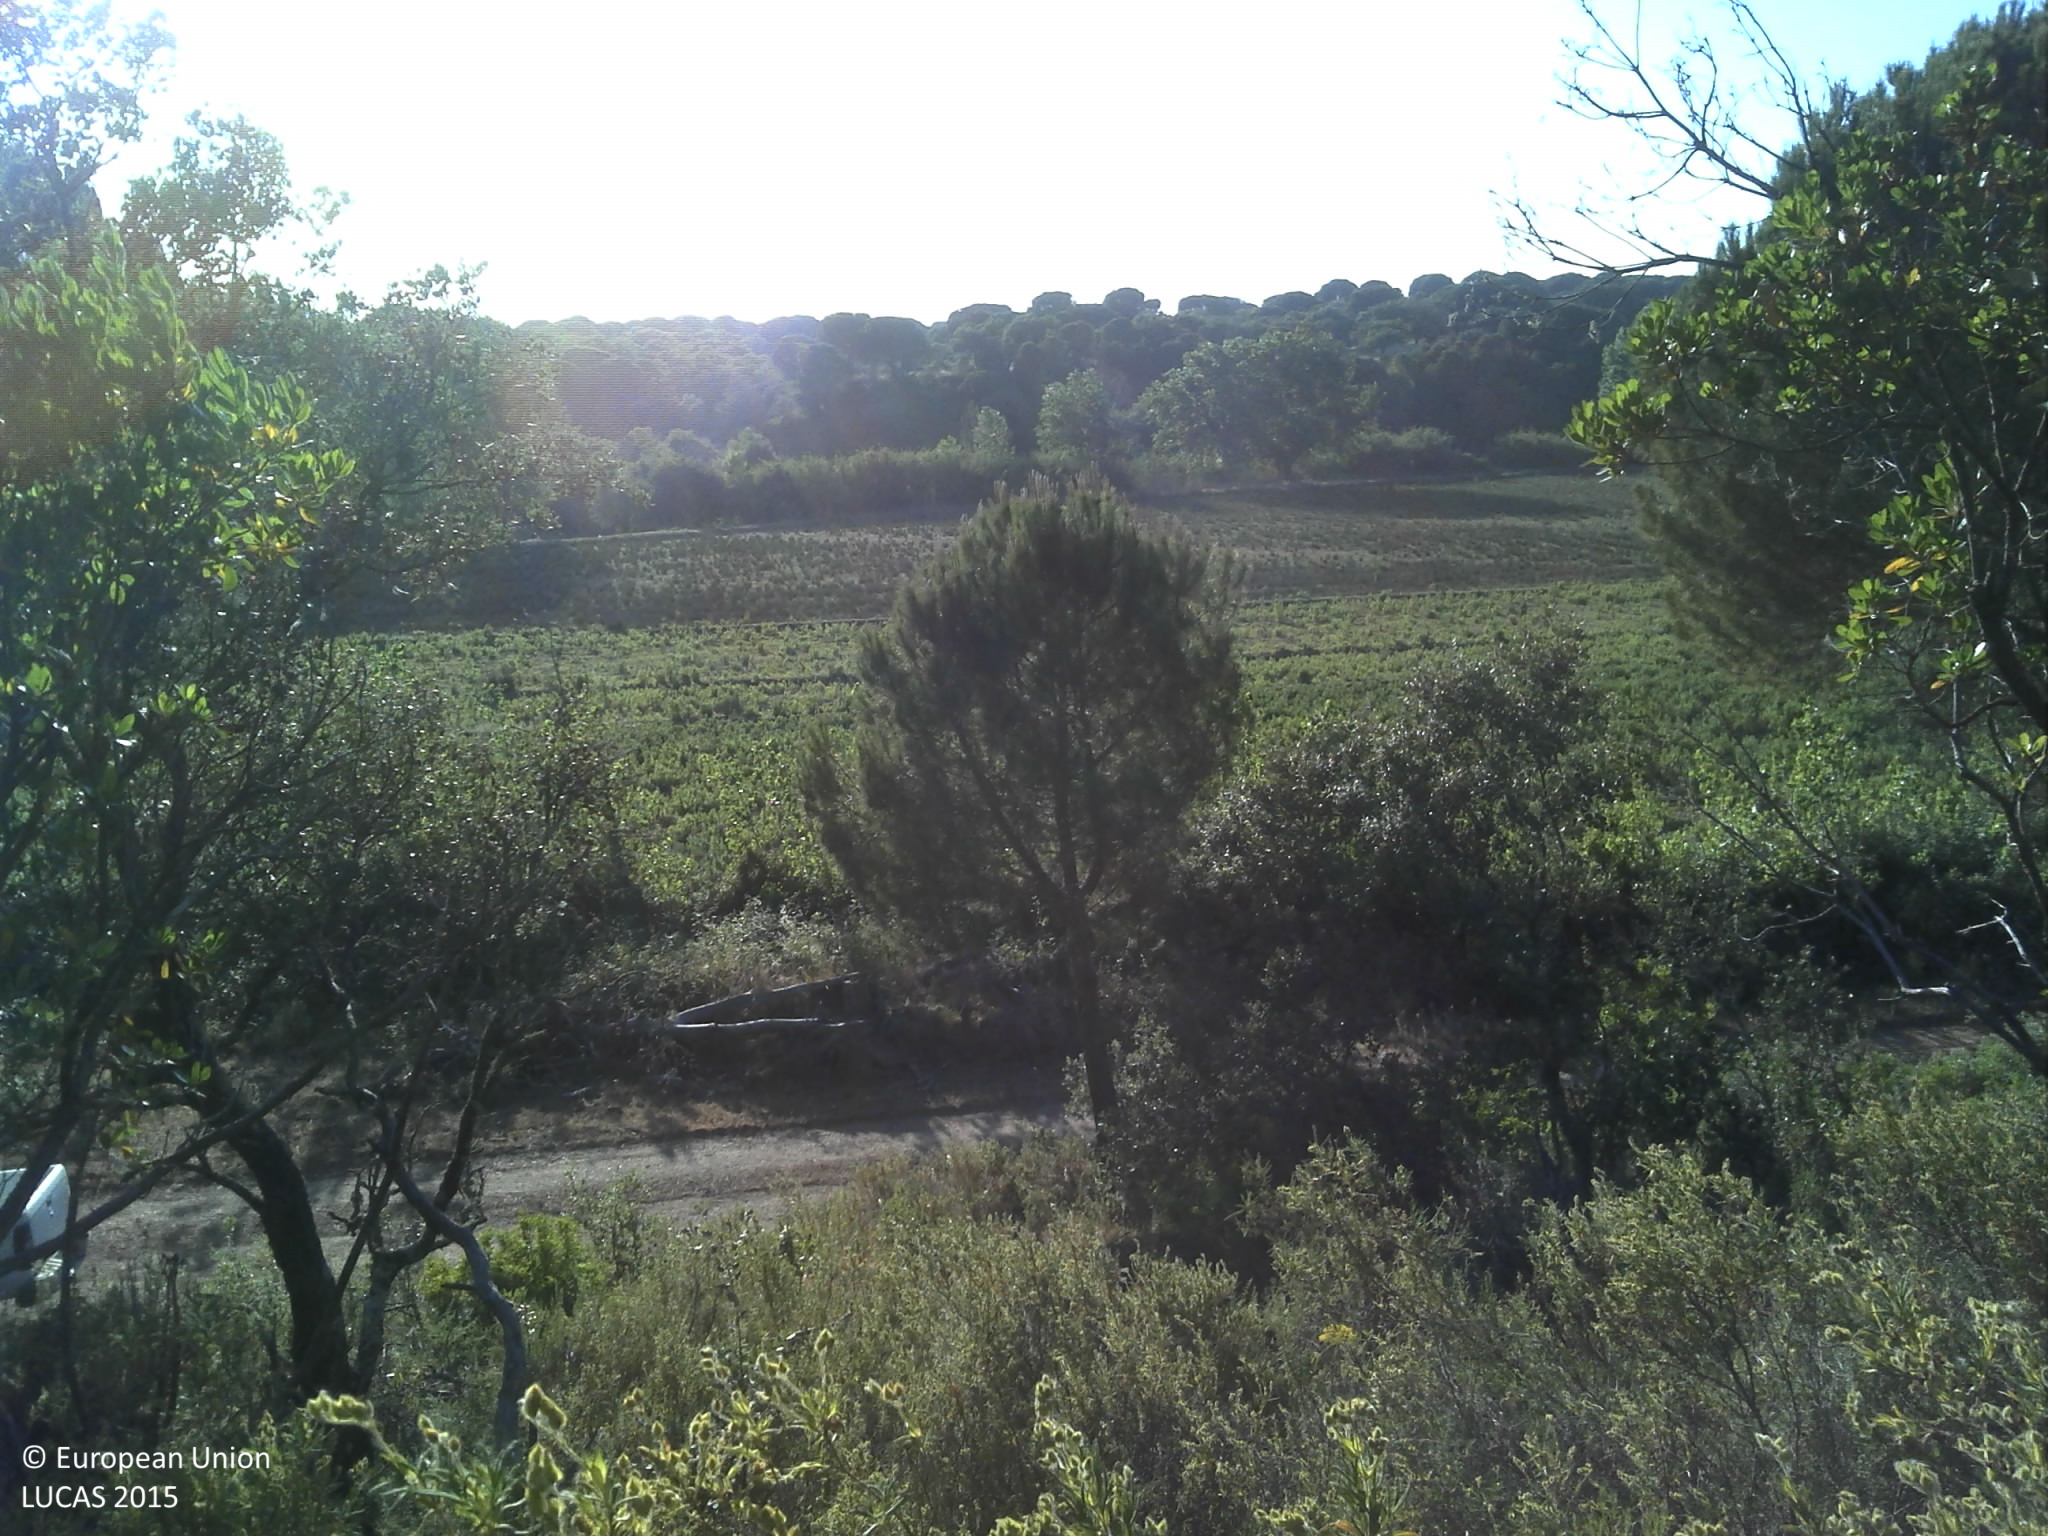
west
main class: Woodland
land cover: Broadleaved woodland
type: broadleaved evergreen forest
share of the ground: 25 - 50 %
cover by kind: shrubs 50 %, broadleaved forest trees 30 %, unconsolidated bare surface 15 %, coniferous forest trees 5 %
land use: Forestry
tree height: > 5 m
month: May
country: PT
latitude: 38.1045
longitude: -8.3917
